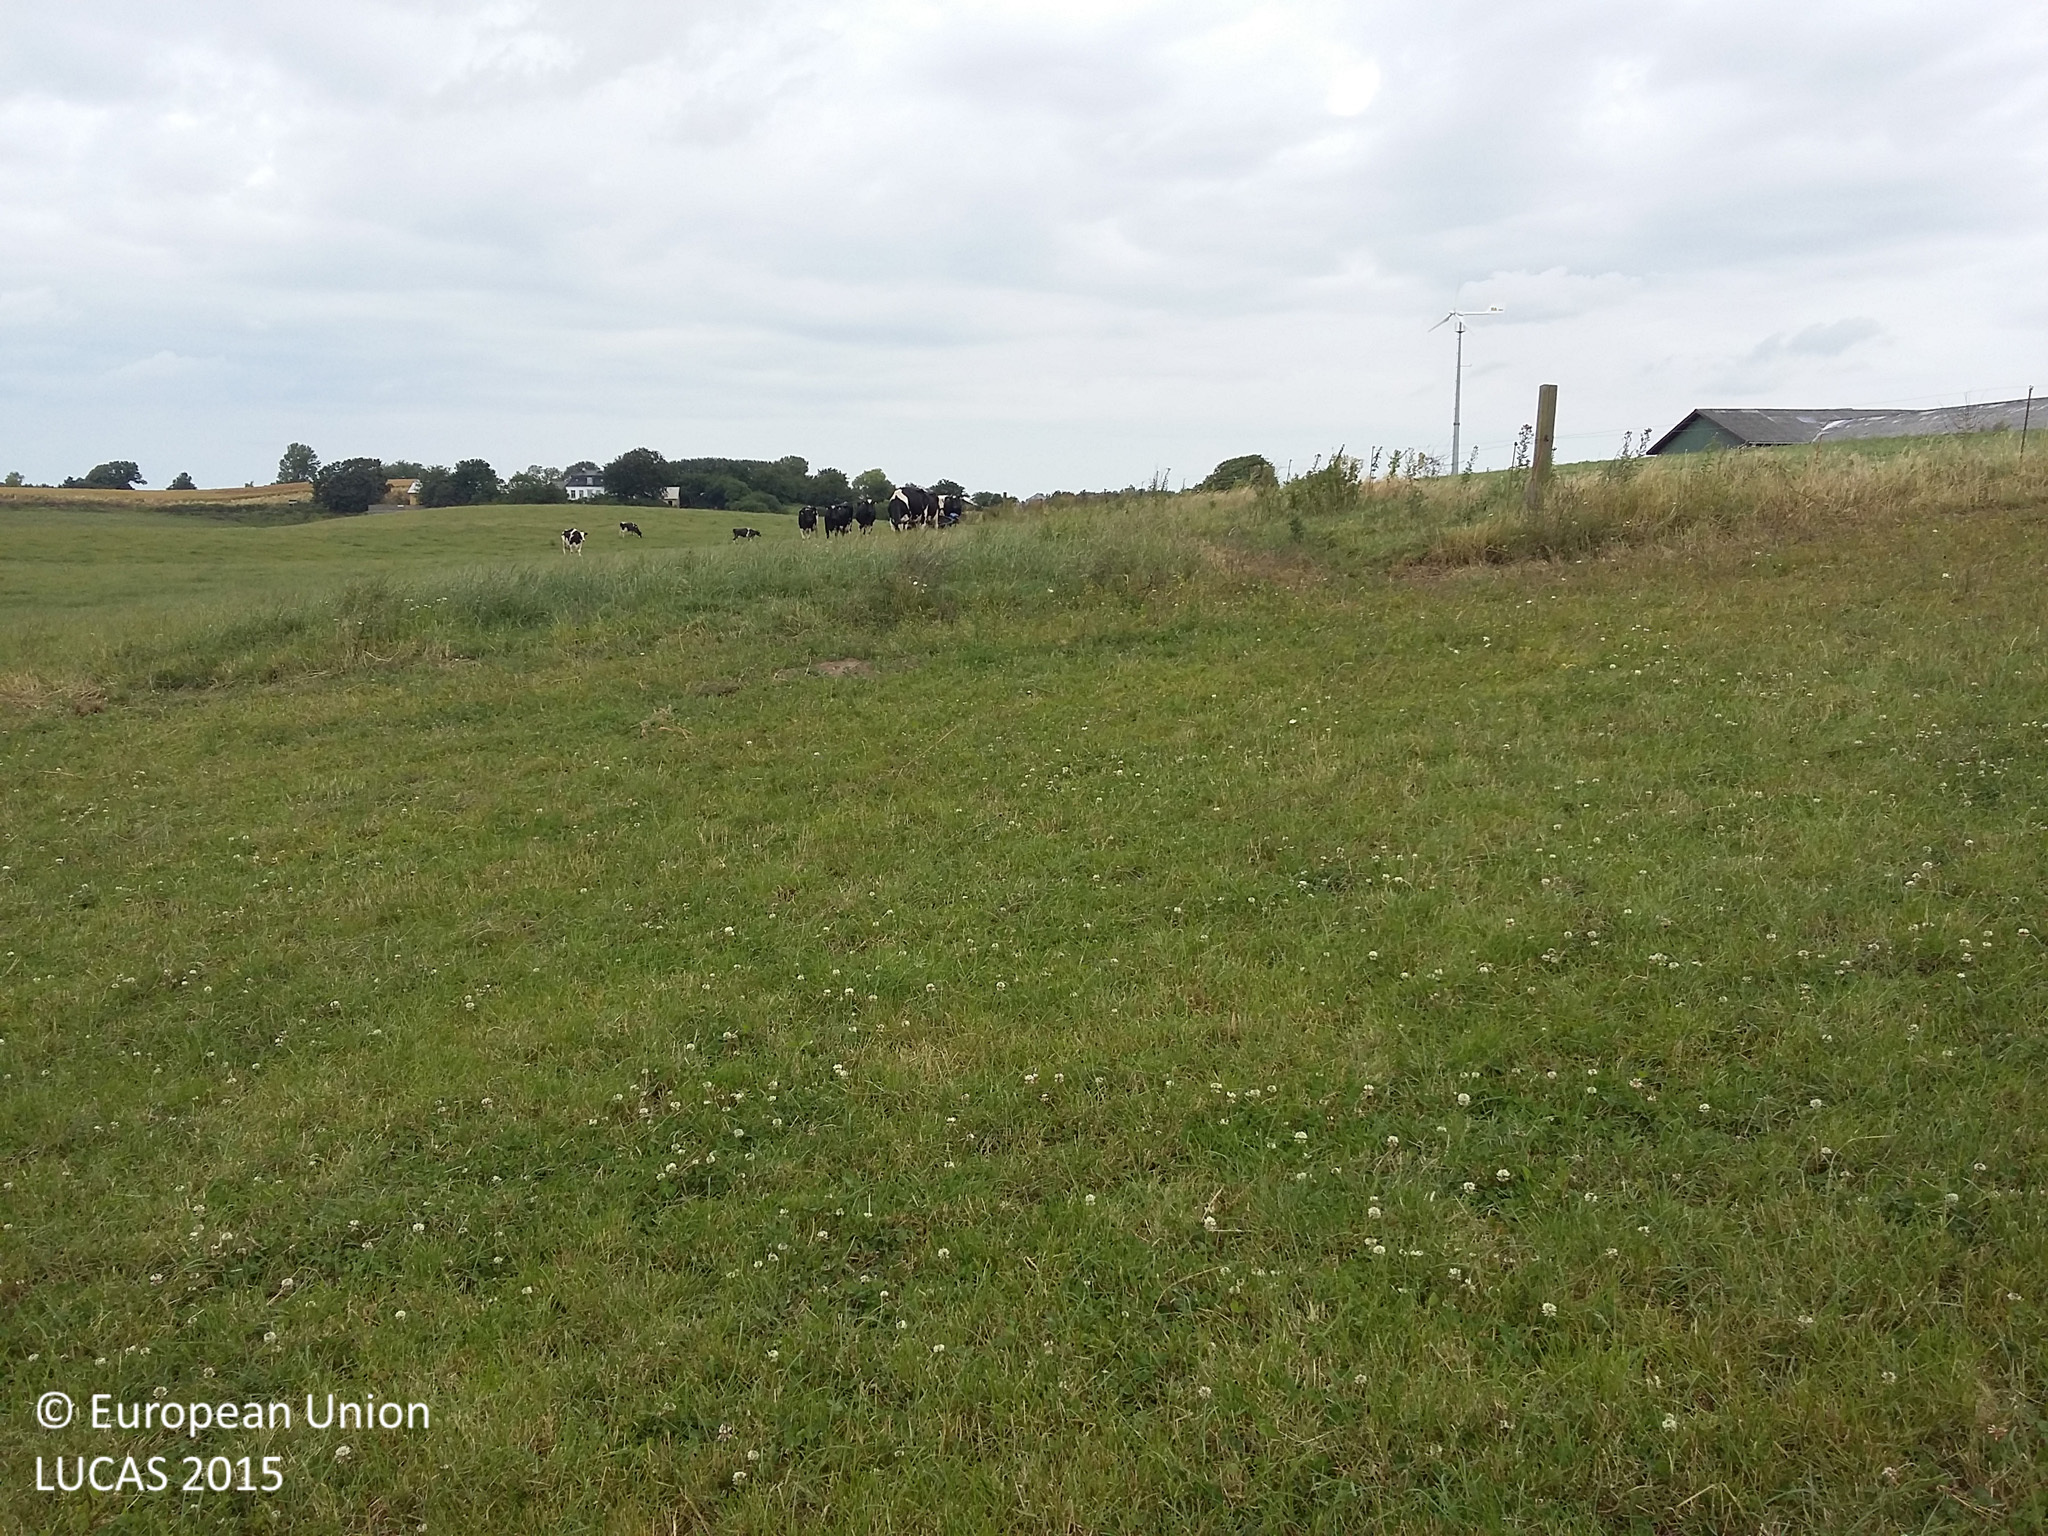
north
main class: Grassland
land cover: Grassland without tree/shrub cover
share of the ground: > 75 %
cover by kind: herbaceous plants 100 %
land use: Agriculture (excluding fallow land and kitchen gardens)
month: July
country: DK
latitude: 55.7418
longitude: 11.9256
